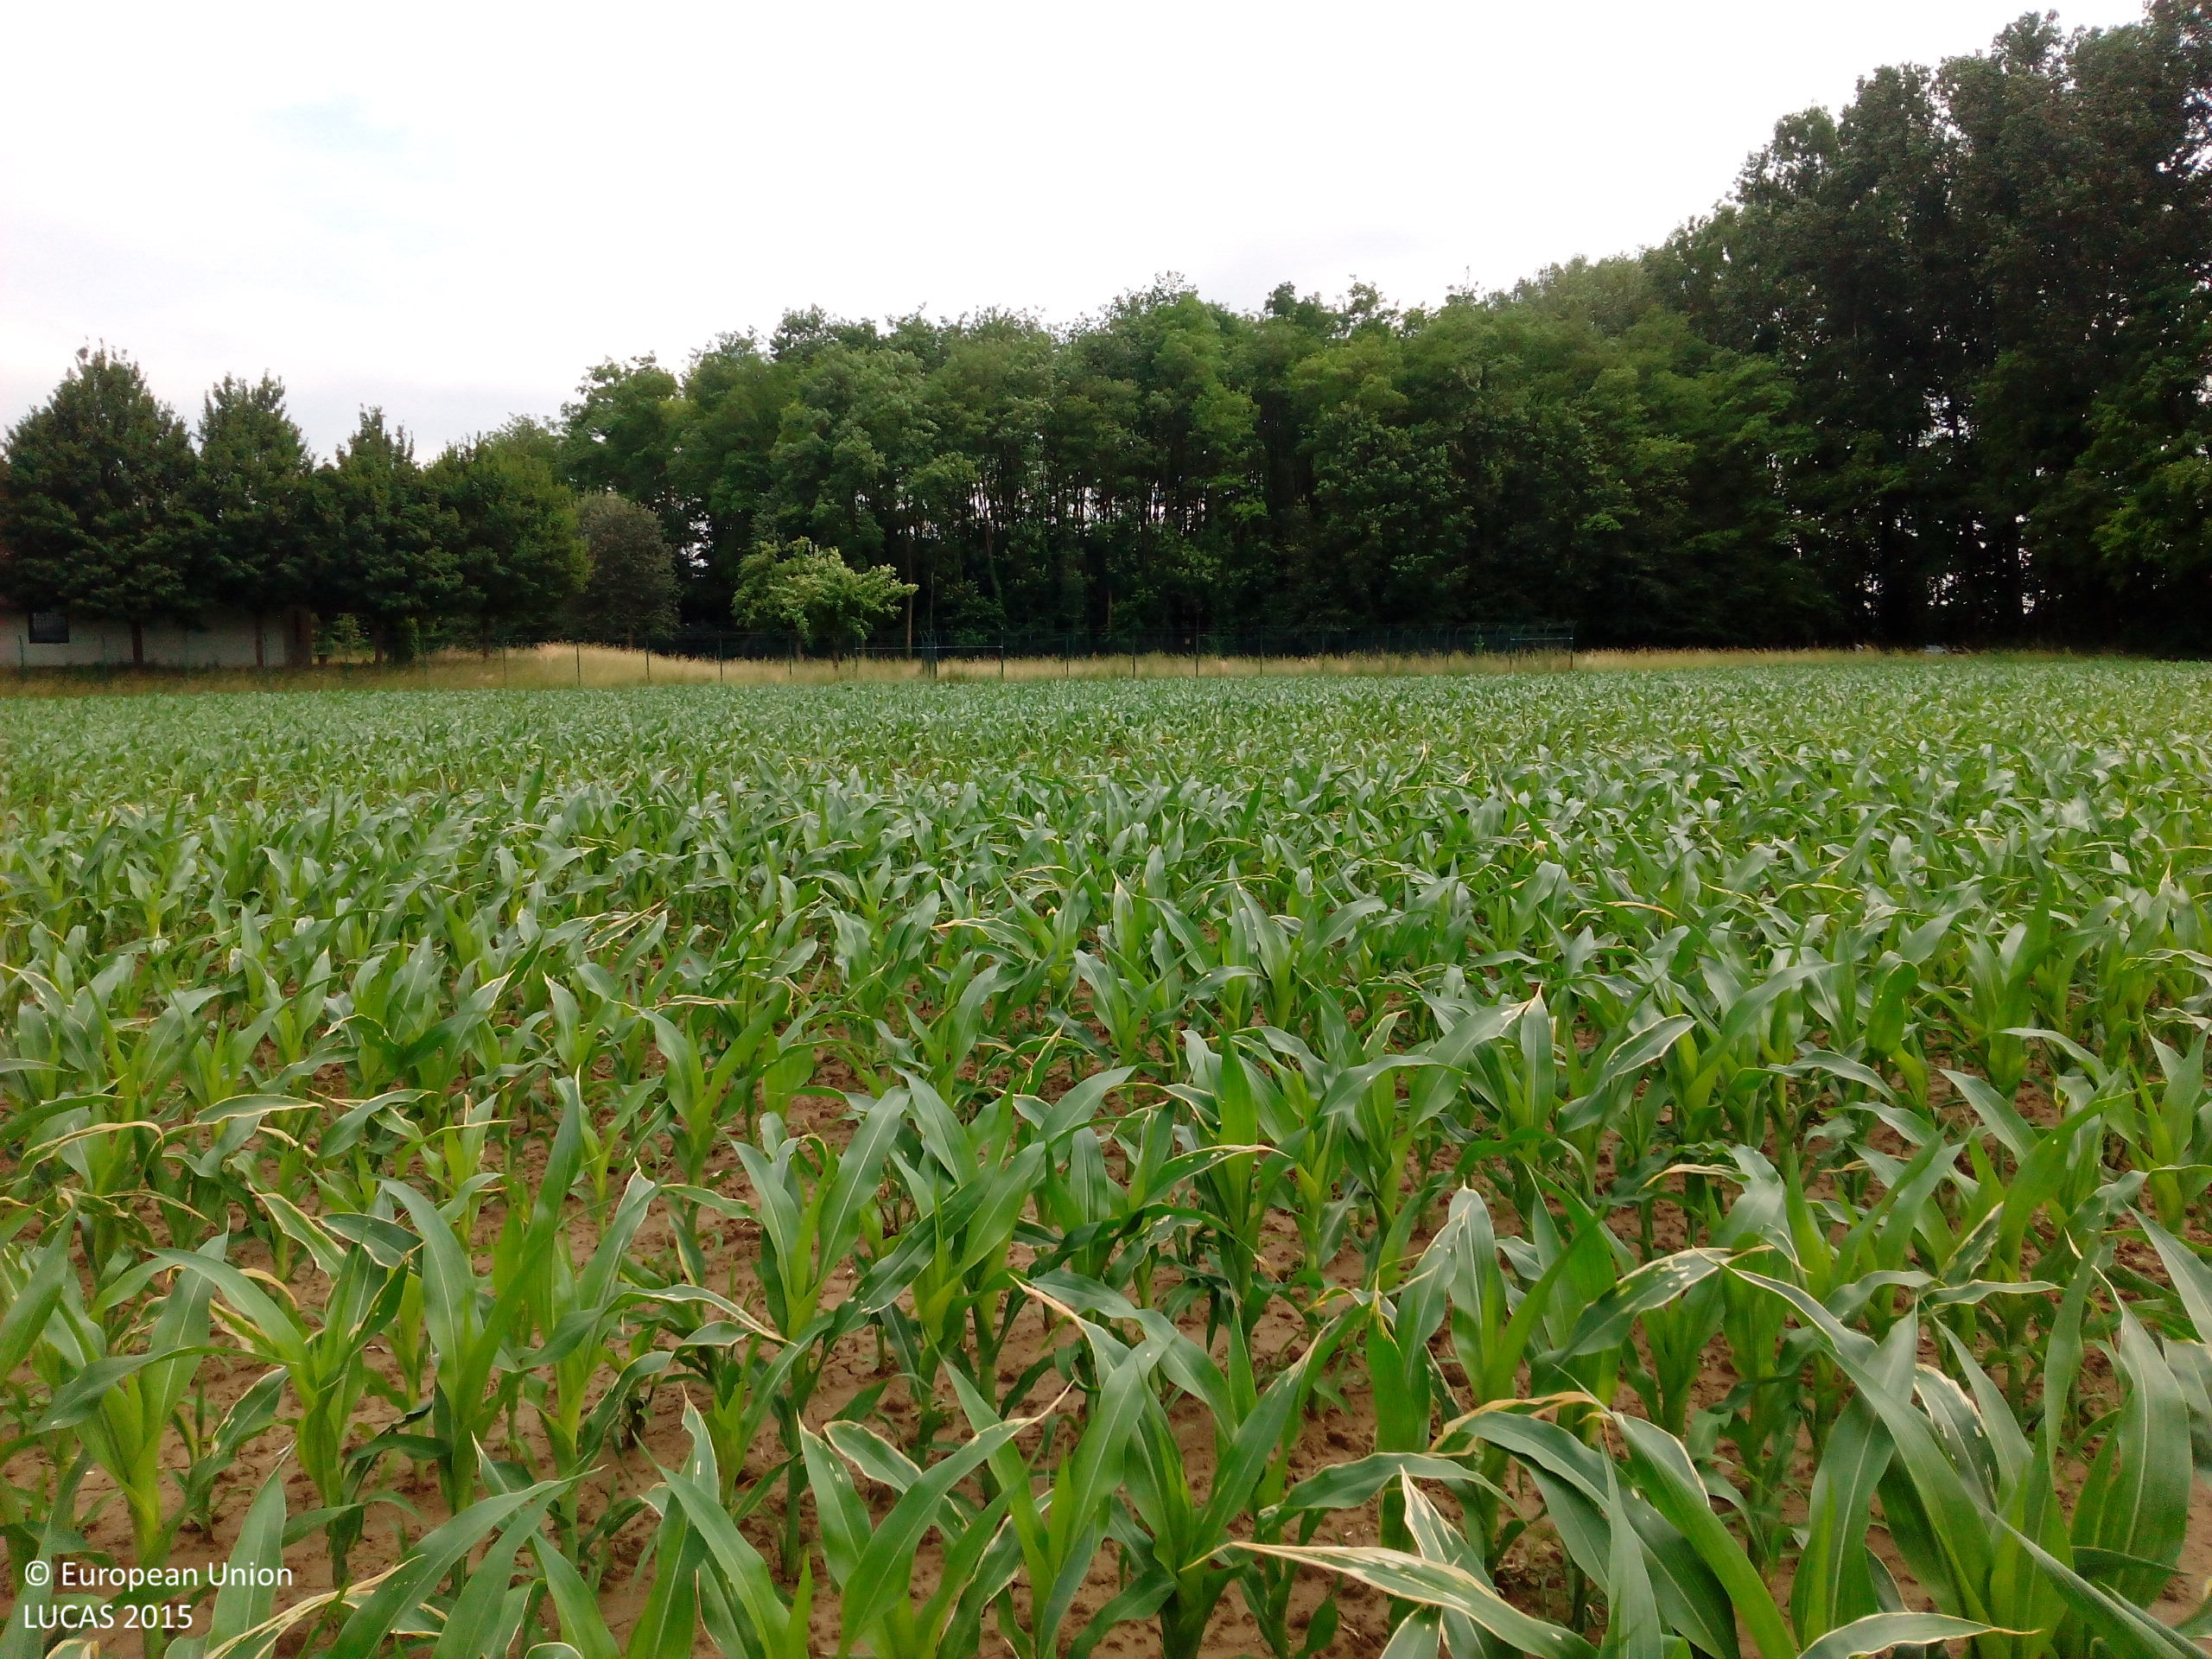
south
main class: Cropland
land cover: Maize
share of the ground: > 75 %
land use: Agriculture (excluding fallow land and kitchen gardens)
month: June
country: DE
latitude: 48.1619
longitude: 7.6214
